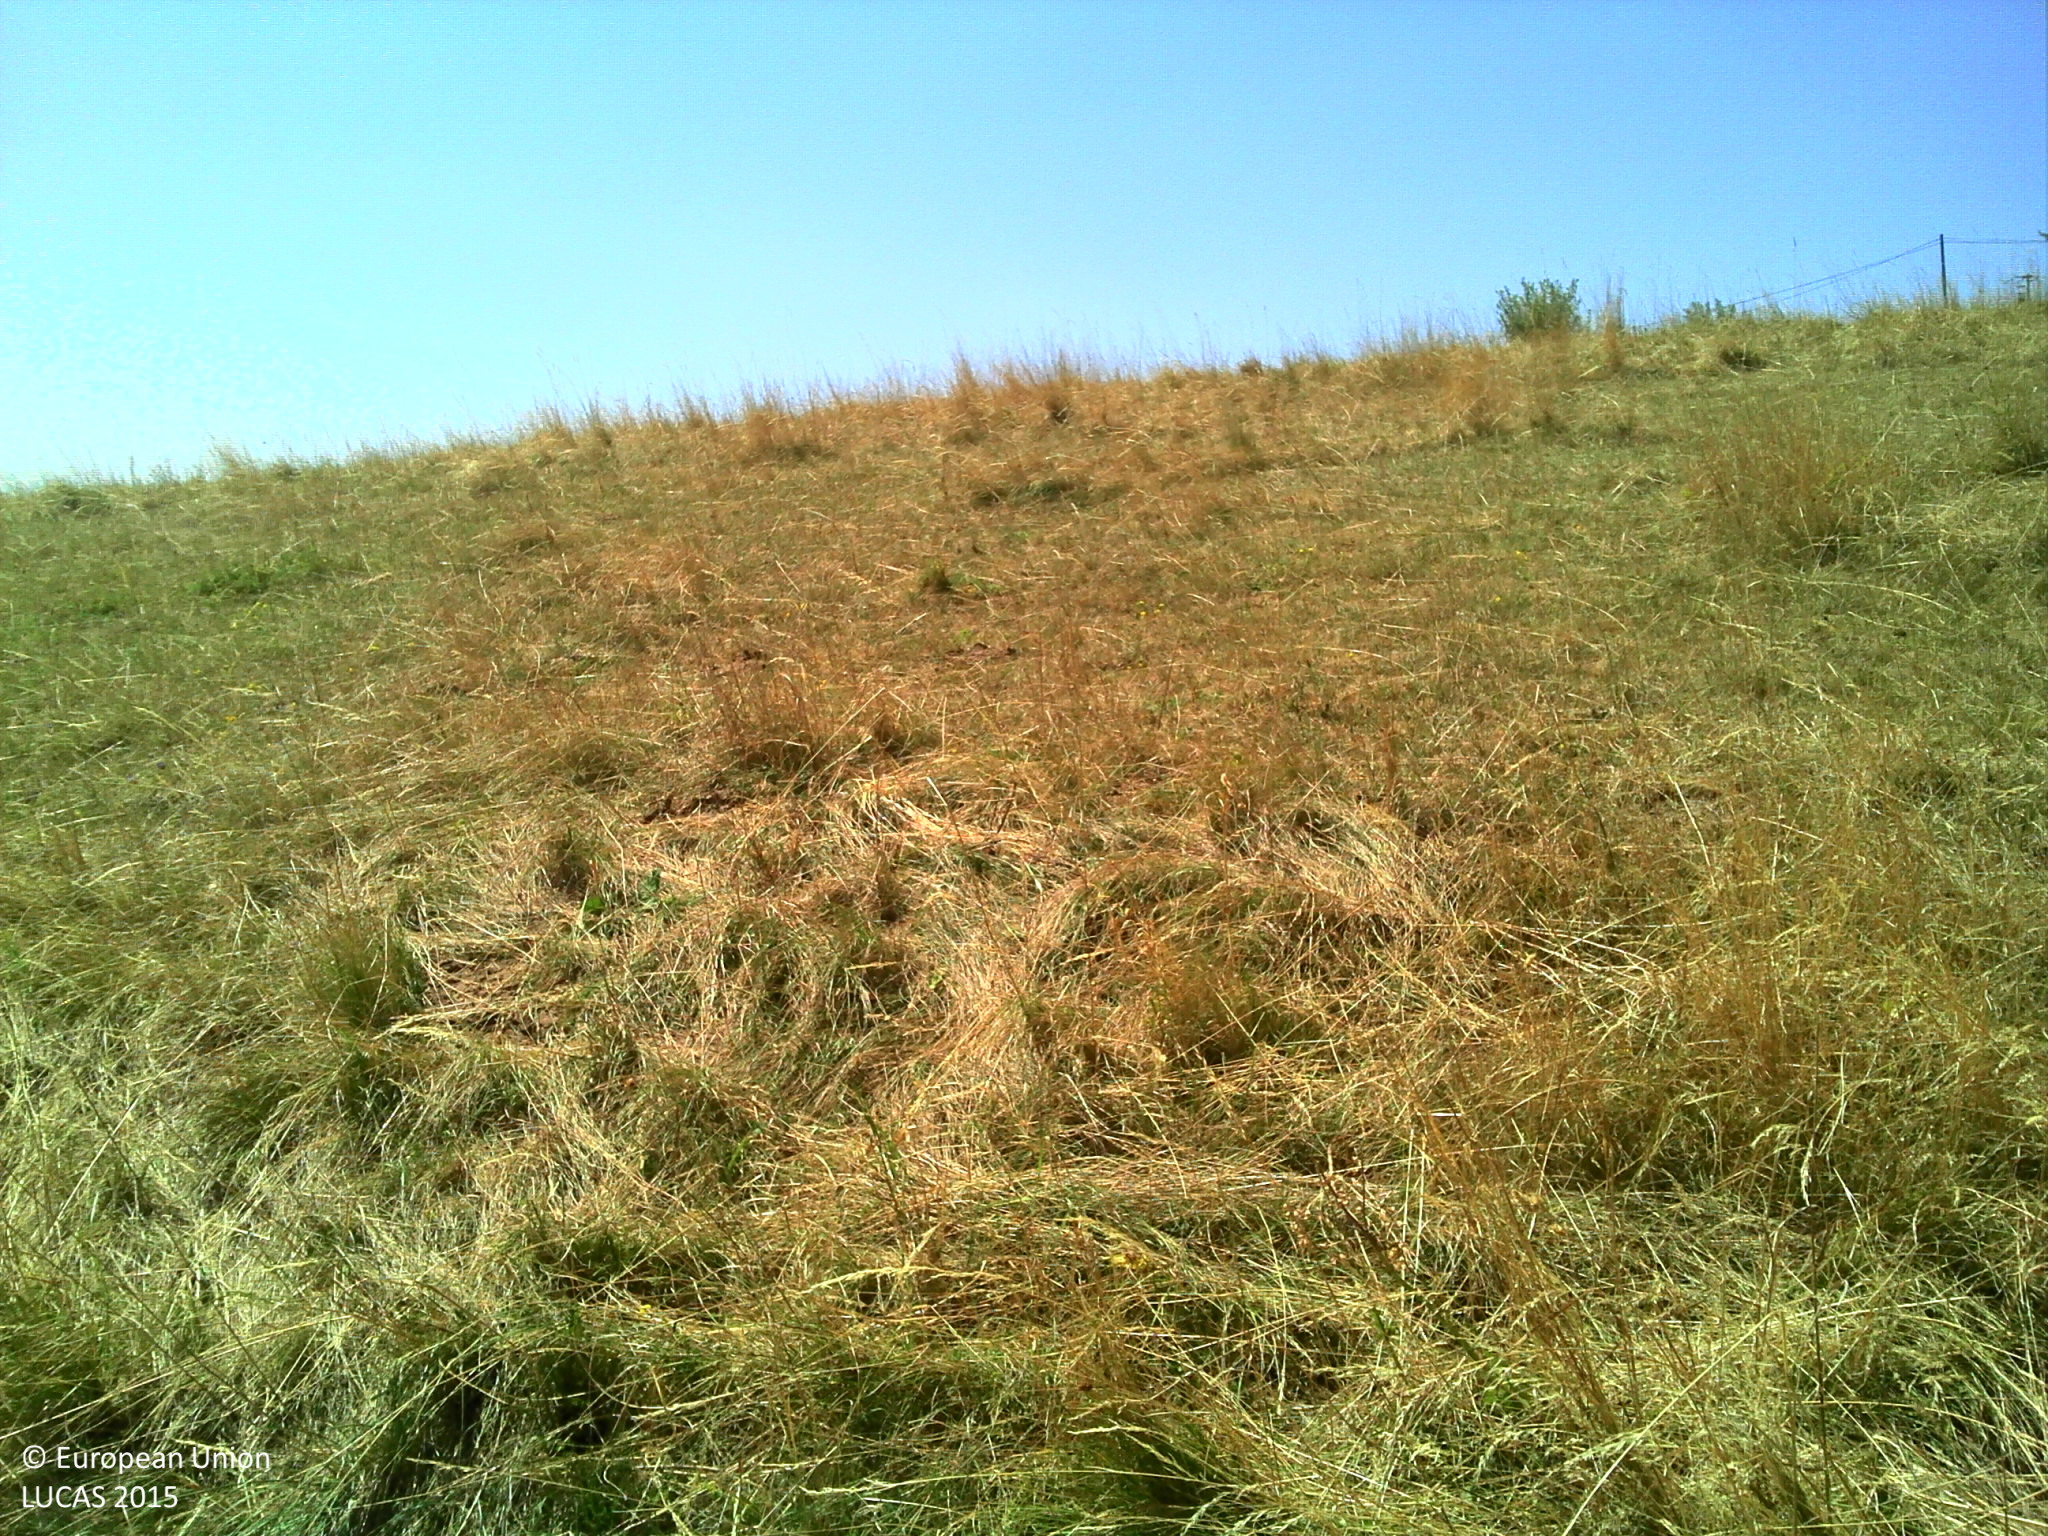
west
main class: Grassland
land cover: Grassland without tree/shrub cover
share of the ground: > 75 %
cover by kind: herbaceous plants 100 %
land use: Agriculture (excluding fallow land and kitchen gardens)
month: July
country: FR
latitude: 45.1970
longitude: 5.2062
